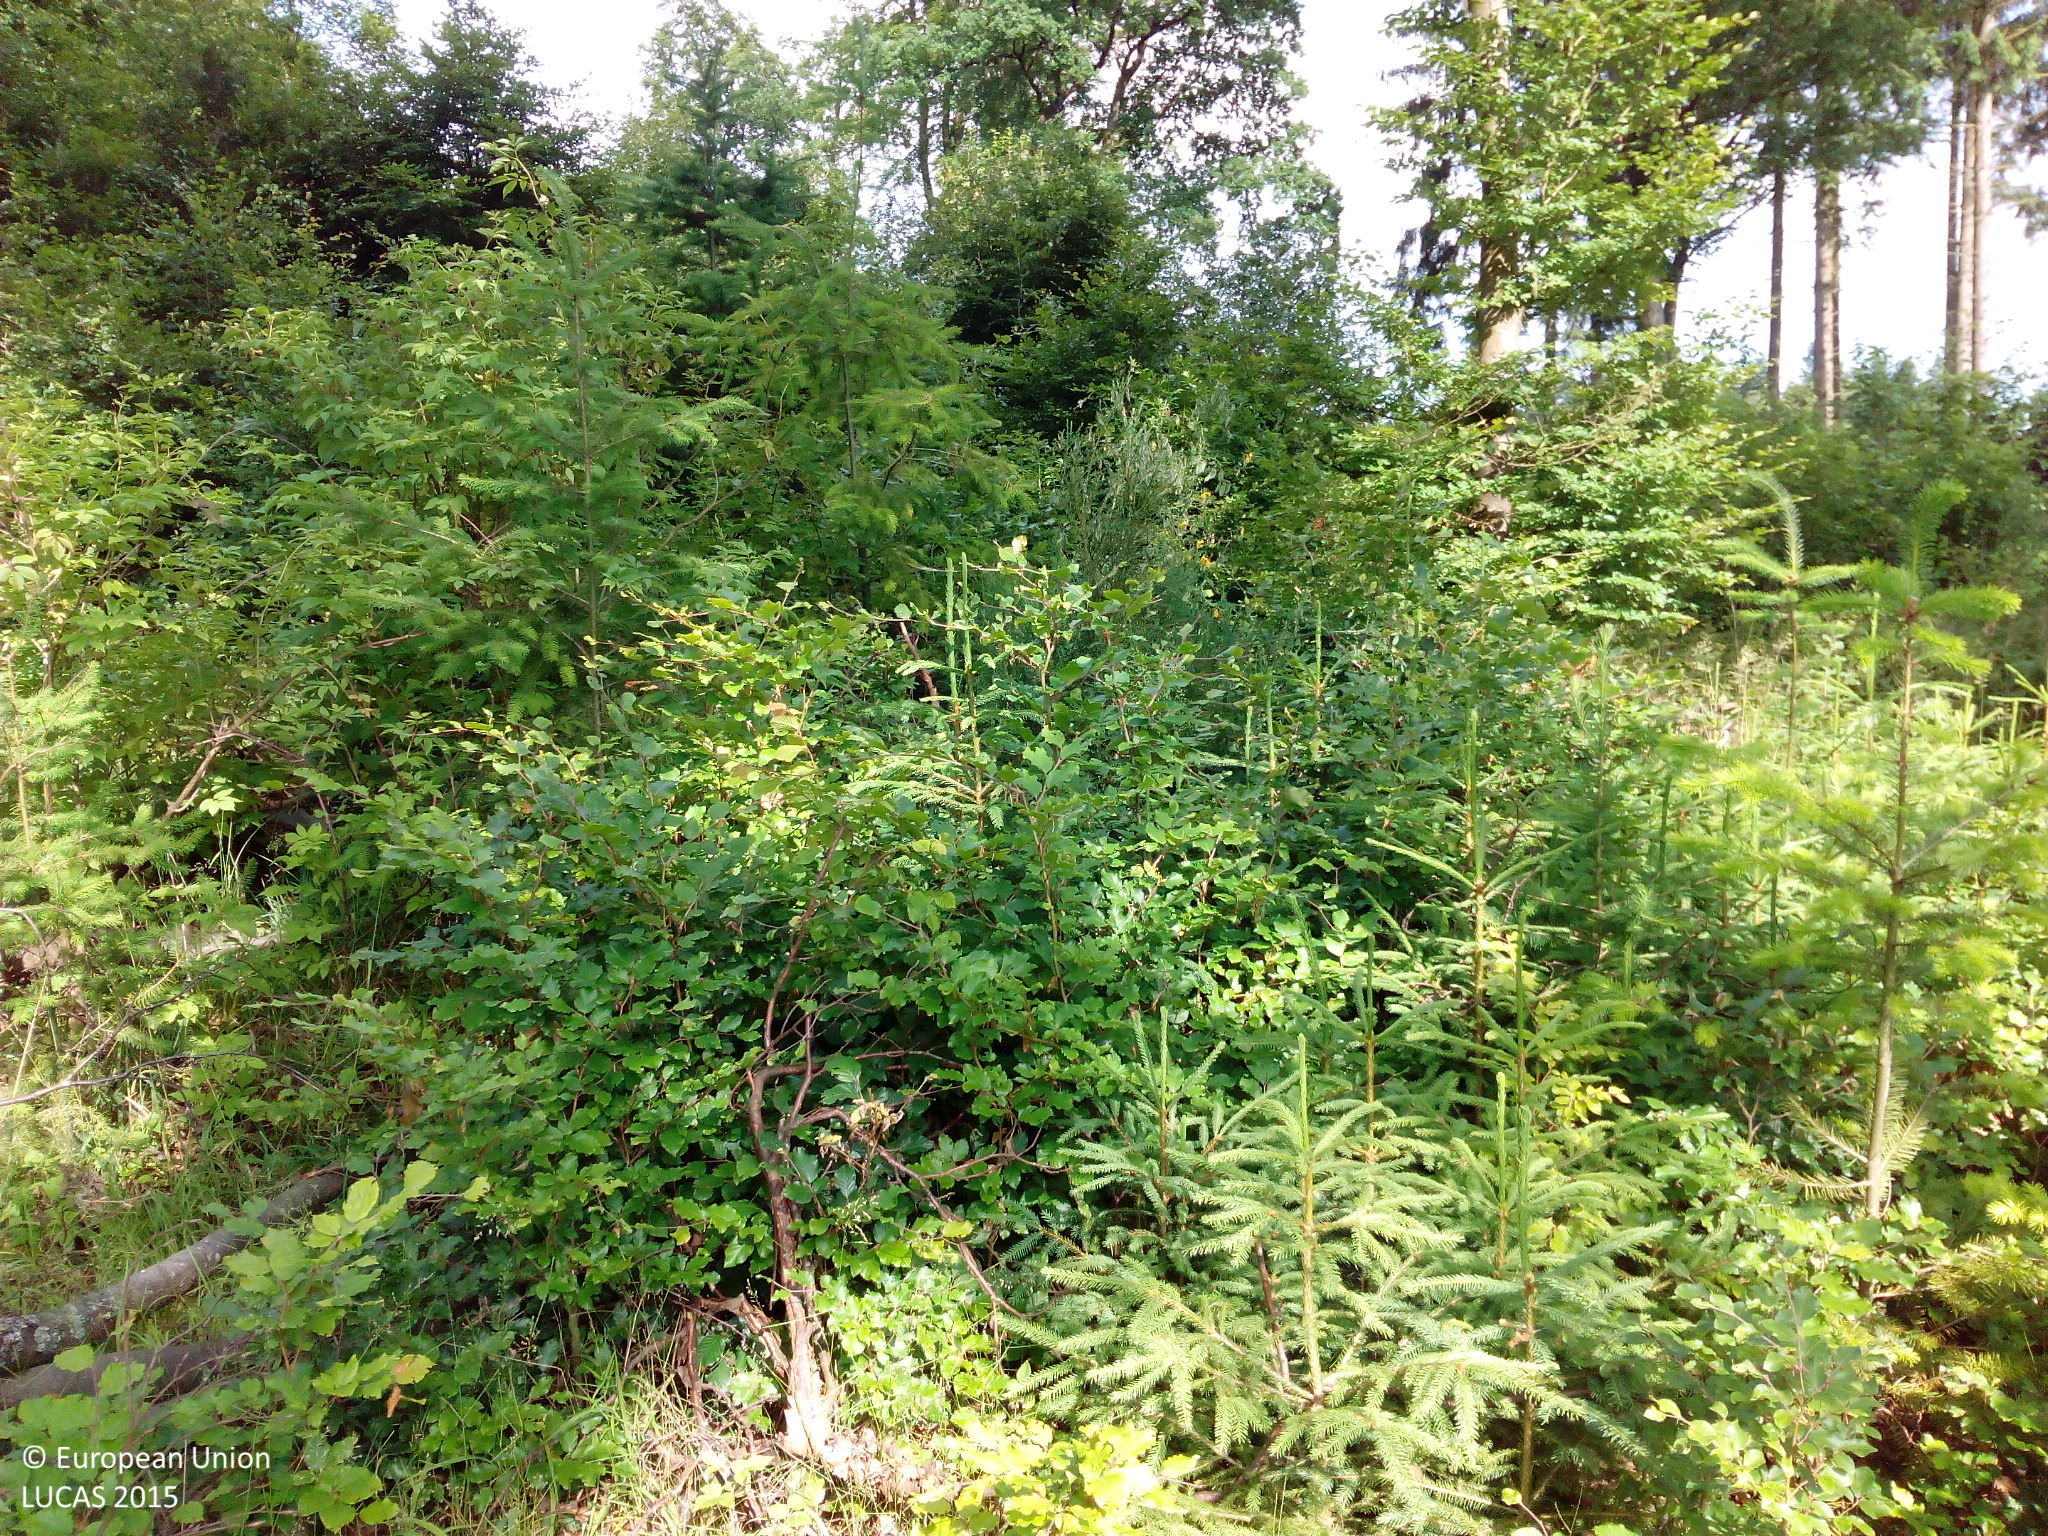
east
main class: Woodland
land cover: Broadleaved woodland
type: beech forest
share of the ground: > 75 %
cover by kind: broadleaved forest trees 95 %, coniferous forest trees 5 %
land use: Forestry
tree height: > 5 m
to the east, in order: Broadleaved woodland; Grass margins; Tracks; Grass margins; Broadleaved woodland; Grassland without tree/shrub cover
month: June
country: DE
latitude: 50.1999
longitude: 7.0441
